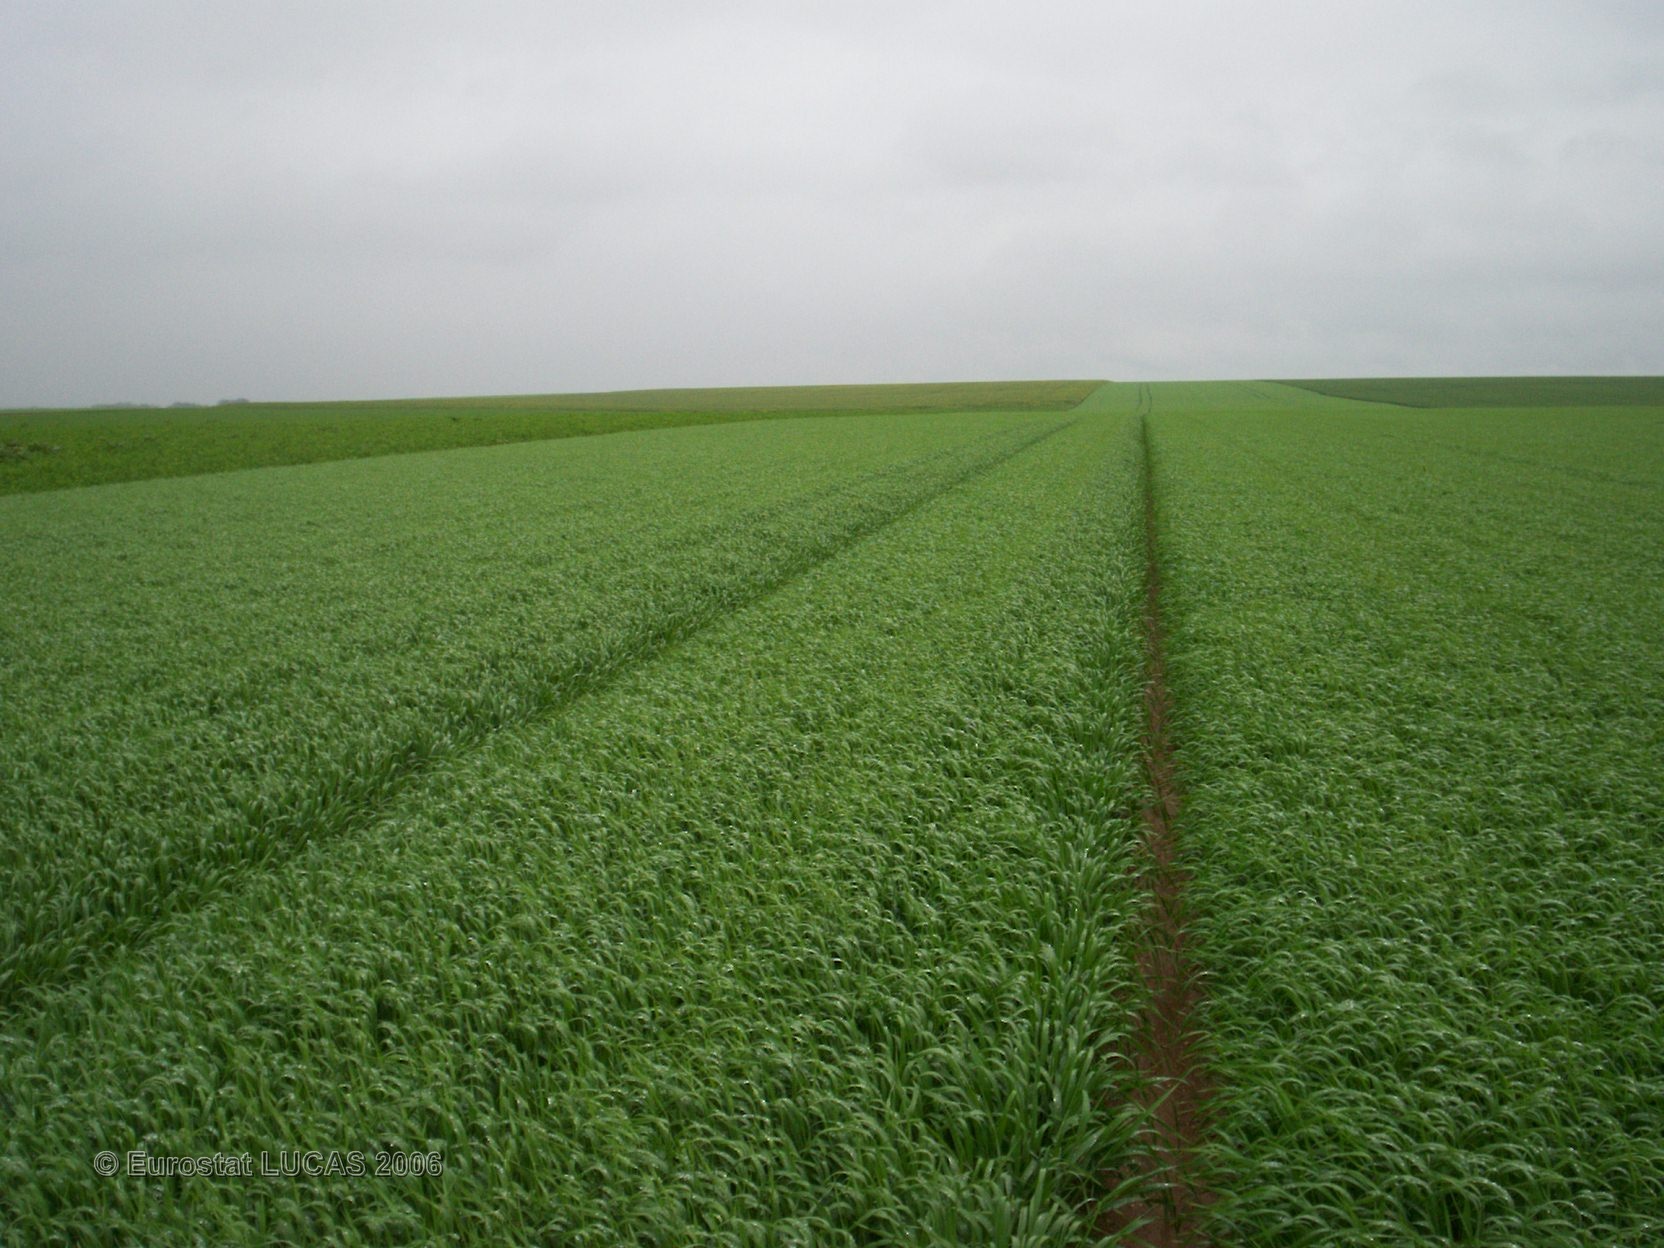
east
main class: Cropland
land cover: Barley
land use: Agriculture (excluding fallow land and kitchen gardens)
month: May
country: FR
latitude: 49.3819
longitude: 4.4450
